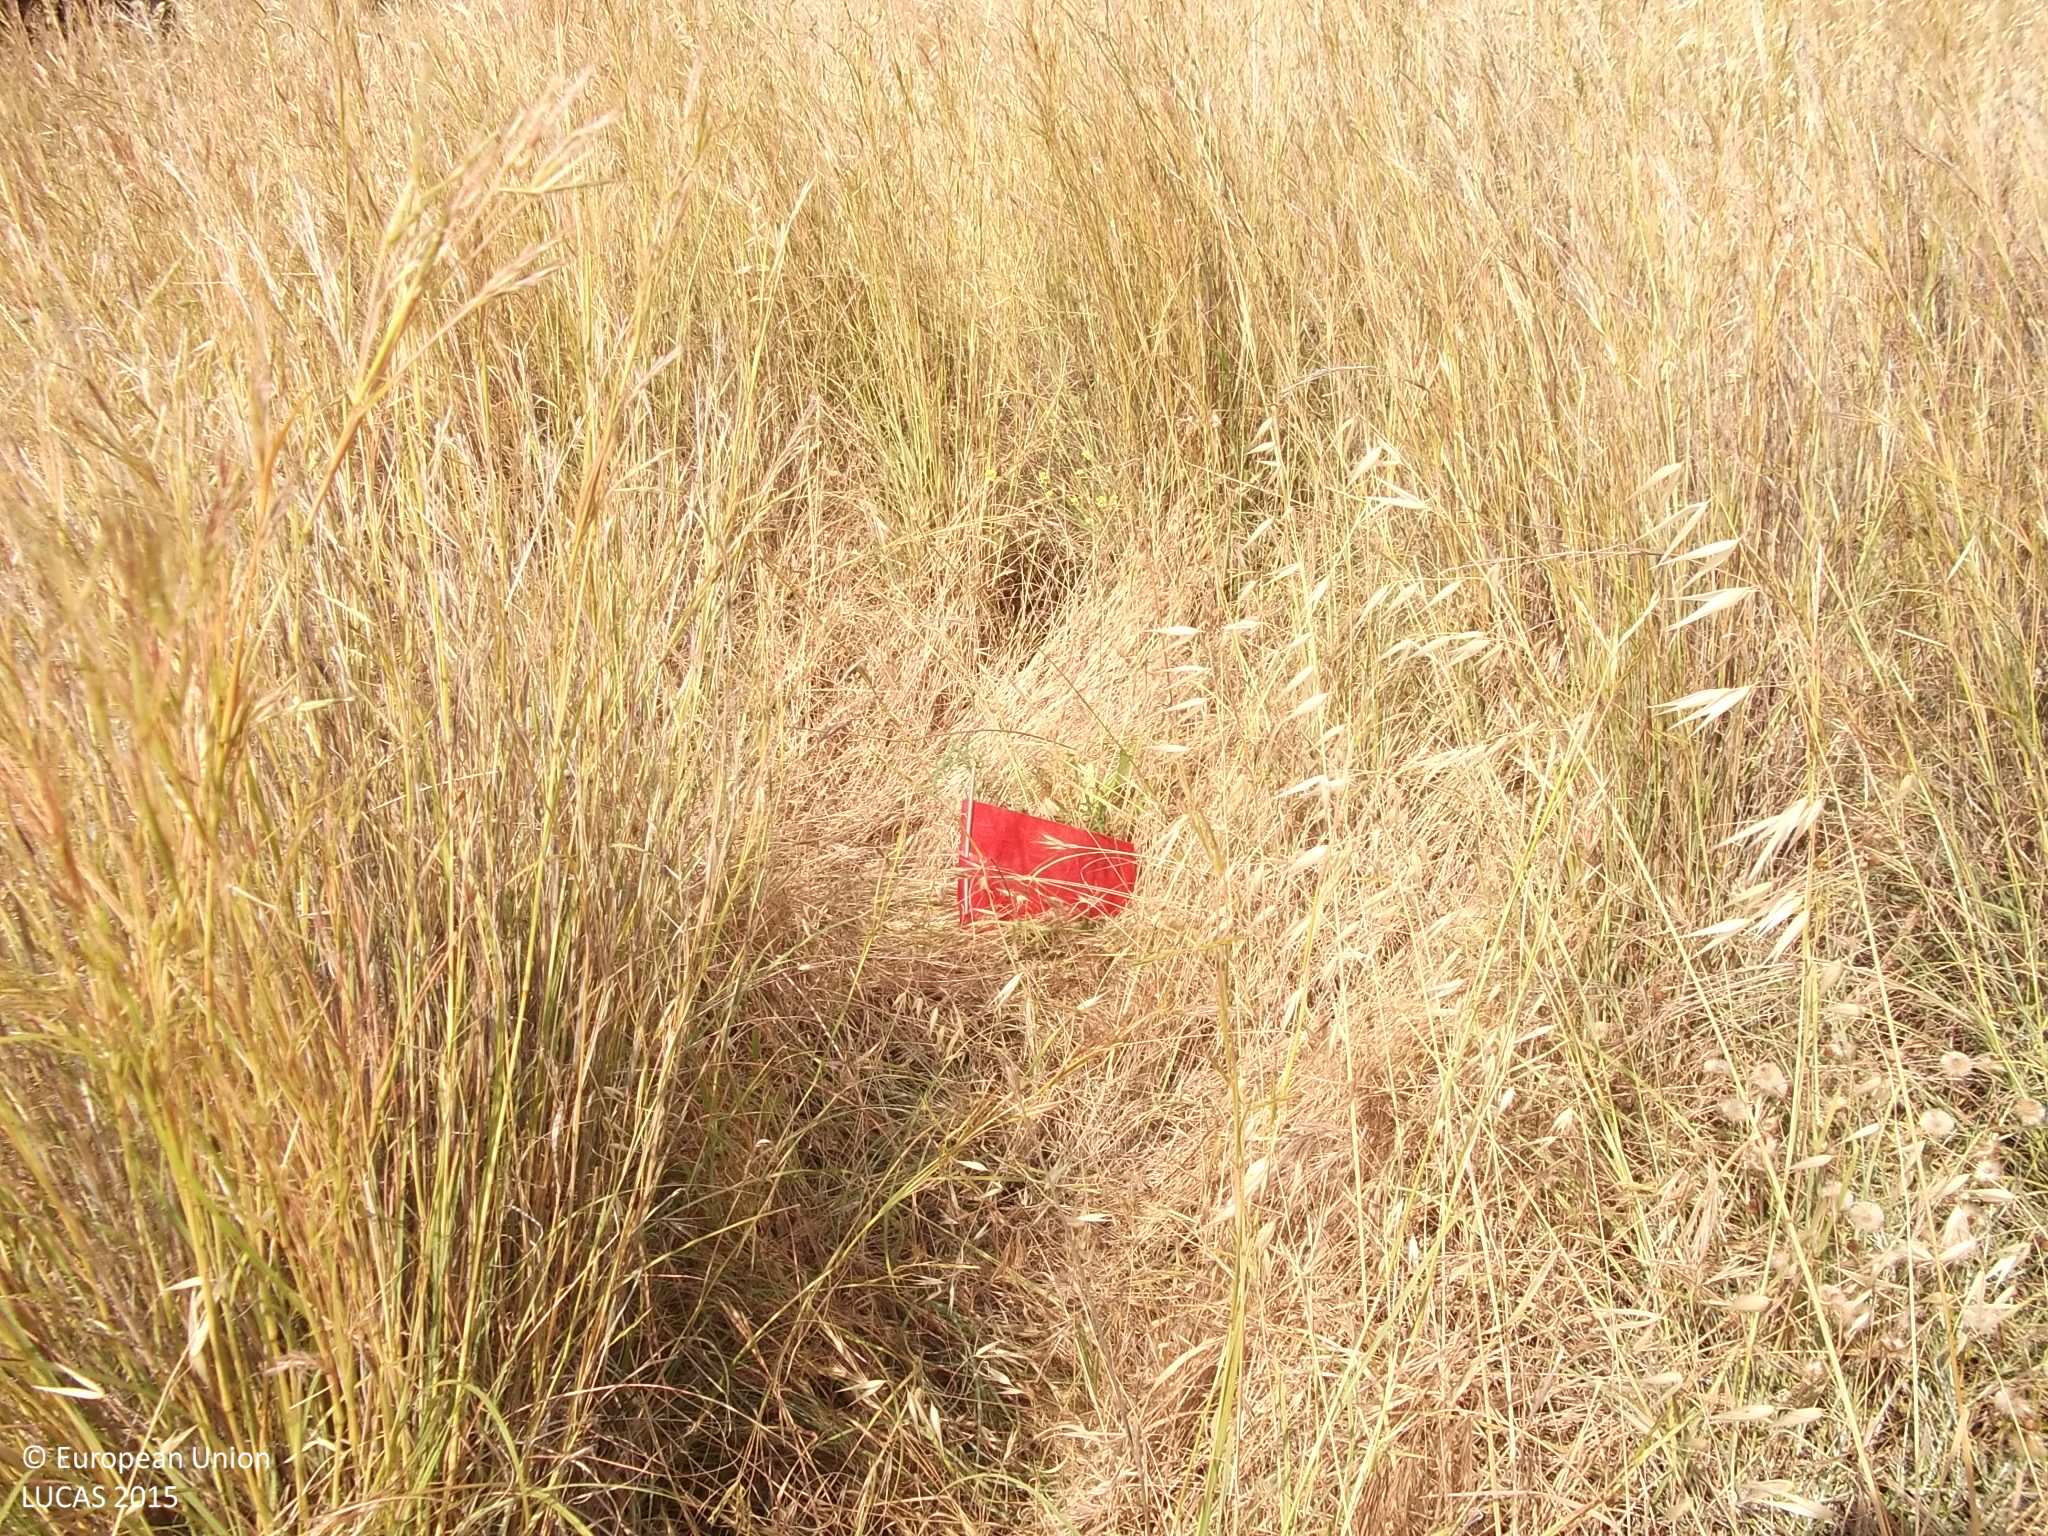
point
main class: Grassland
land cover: Grassland without tree/shrub cover
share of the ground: > 75 %
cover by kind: herbaceous plants 100 %
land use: Semi-natural and natural areas not in use
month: May
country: CY
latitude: 34.7672
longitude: 32.5131
